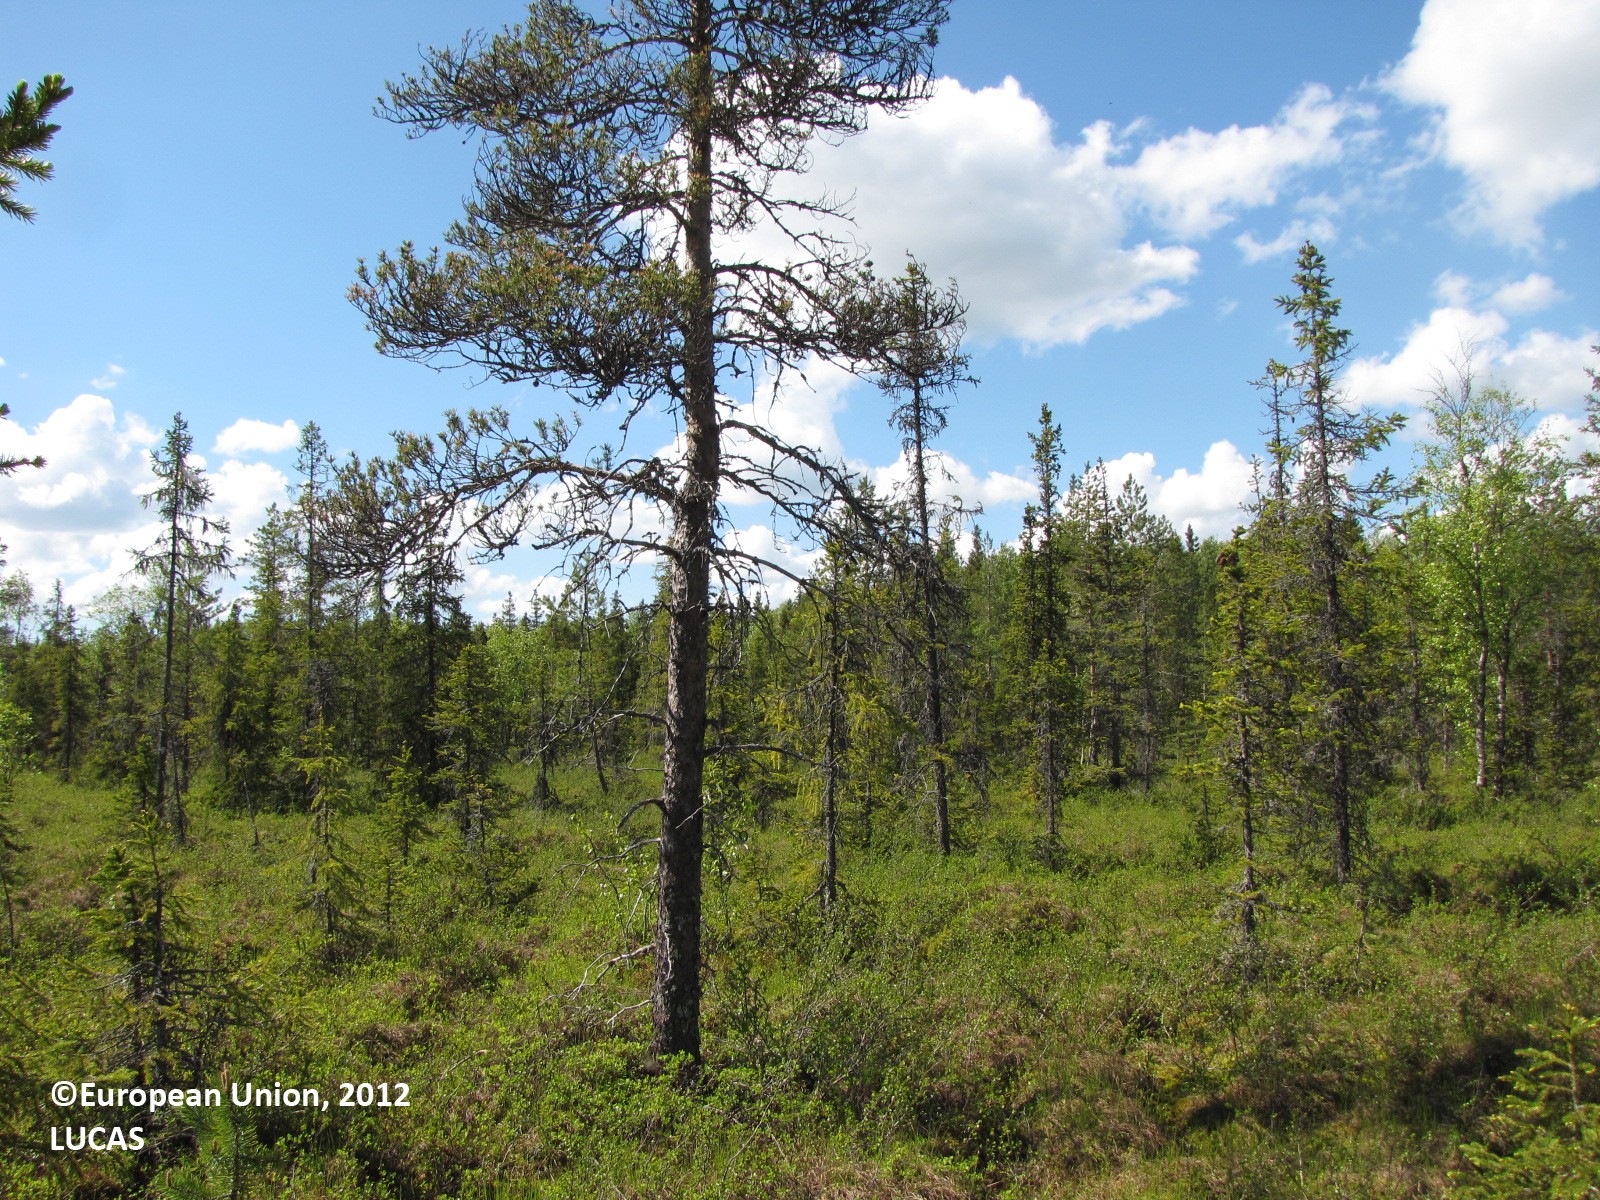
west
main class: Woodland
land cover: Spruce dominated coniferous woodland
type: boreal forest
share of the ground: 25 - 50 %
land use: Forestry
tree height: > 5 m
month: June
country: FI
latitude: 65.9757
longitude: 24.7380
